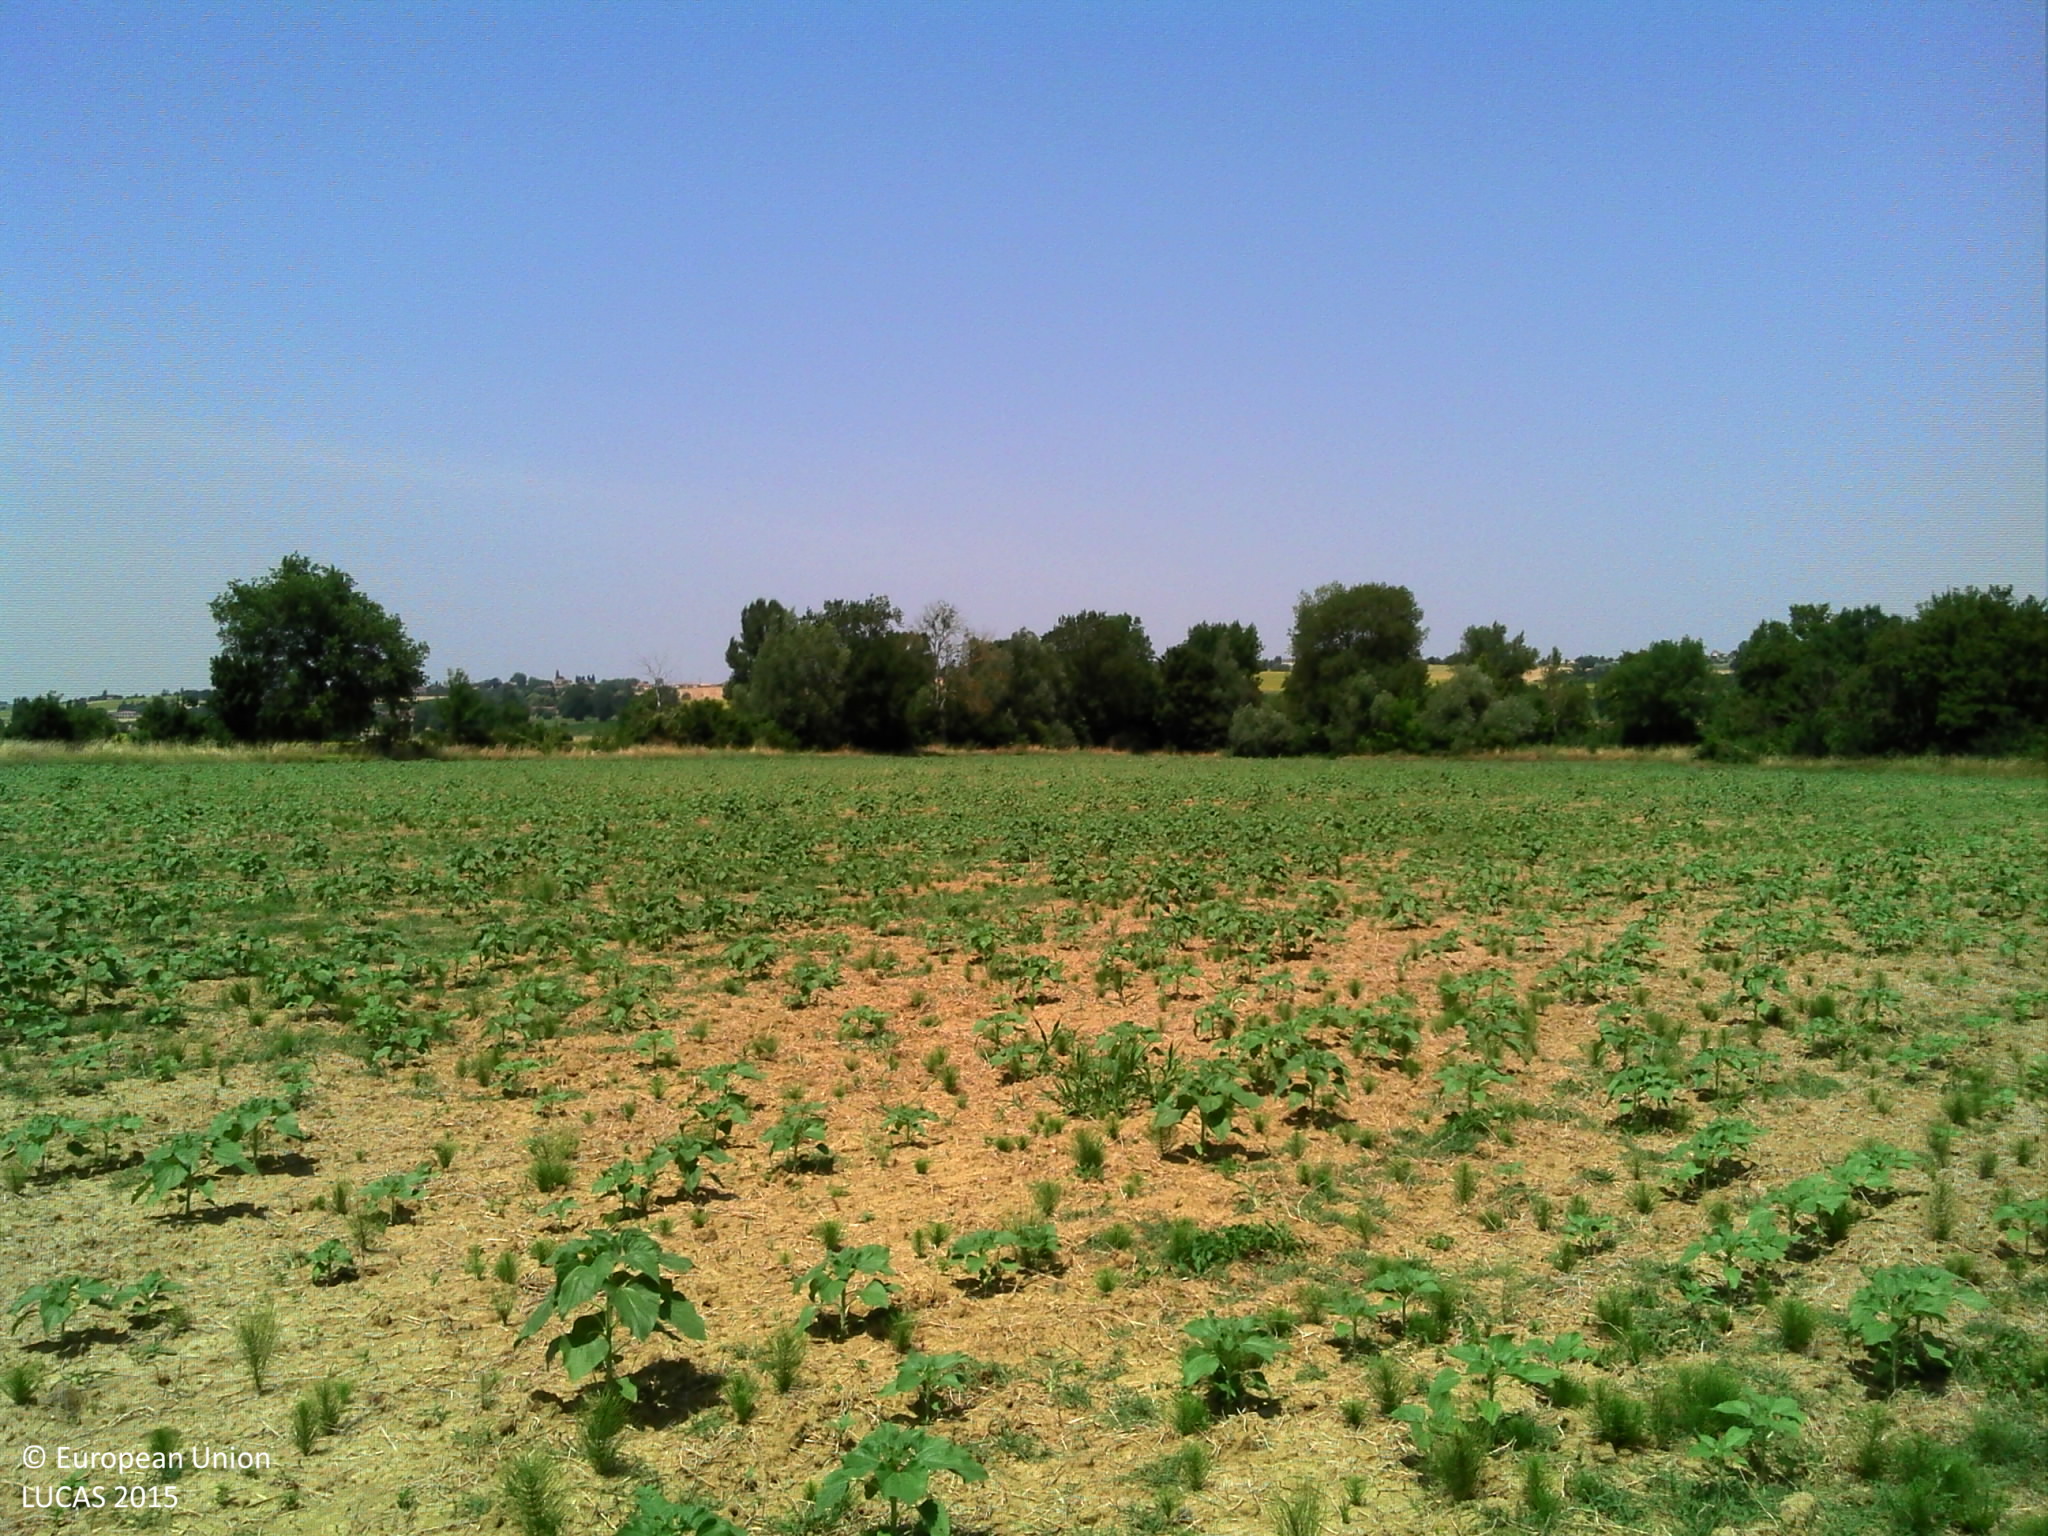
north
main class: Cropland
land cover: Sunflower
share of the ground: > 75 %
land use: Agriculture (excluding fallow land and kitchen gardens)
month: July
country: FR
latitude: 43.6040
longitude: 1.7406
